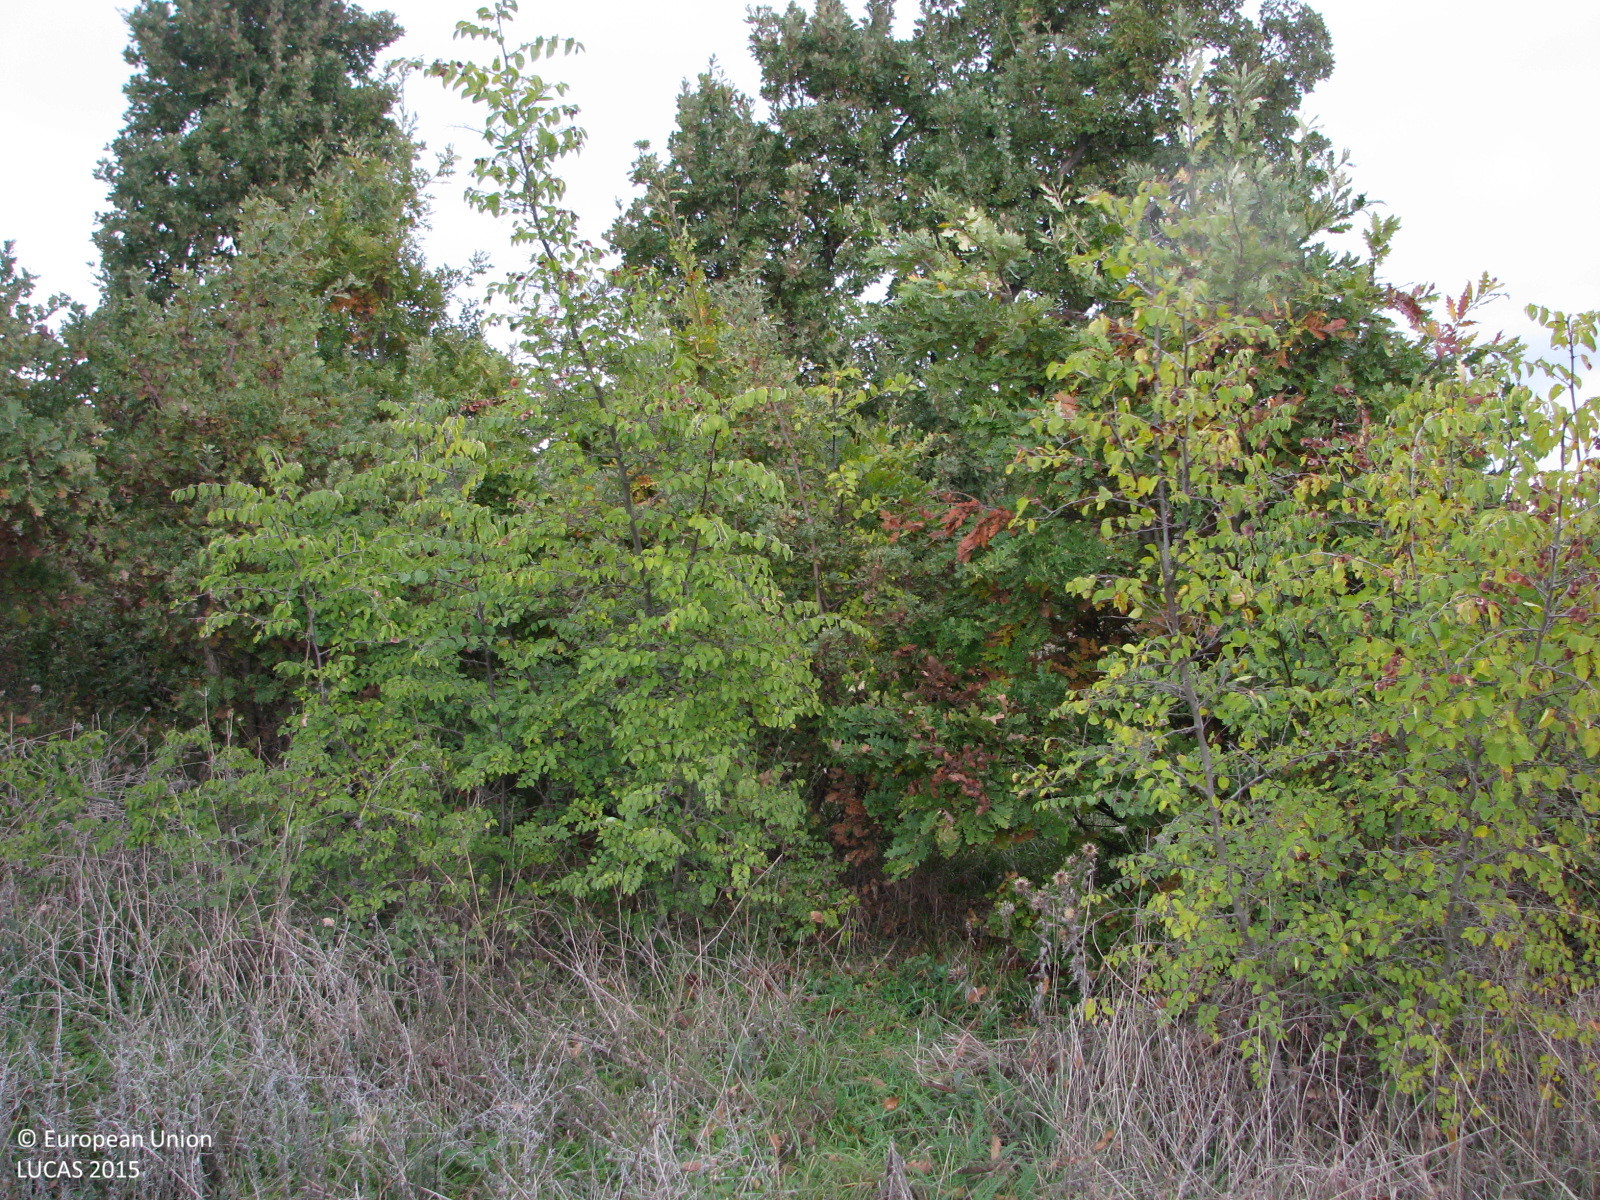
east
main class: Grassland
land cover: Grassland with sparse tree/shrub cover
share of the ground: > 75 %
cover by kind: herbaceous plants 85 %, shrubs 10 %, broadleaved forest trees 5 %
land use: Semi-natural and natural areas not in use
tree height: < 5 m
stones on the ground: < 10 %
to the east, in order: Grassland with sparse tree/shrub cover; Shrubland with sparse tree cover; Broadleaved woodland; Grassland with sparse tree/shrub cover; Broadleaved woodland
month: October
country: BG
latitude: 41.9884
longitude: 26.6129
